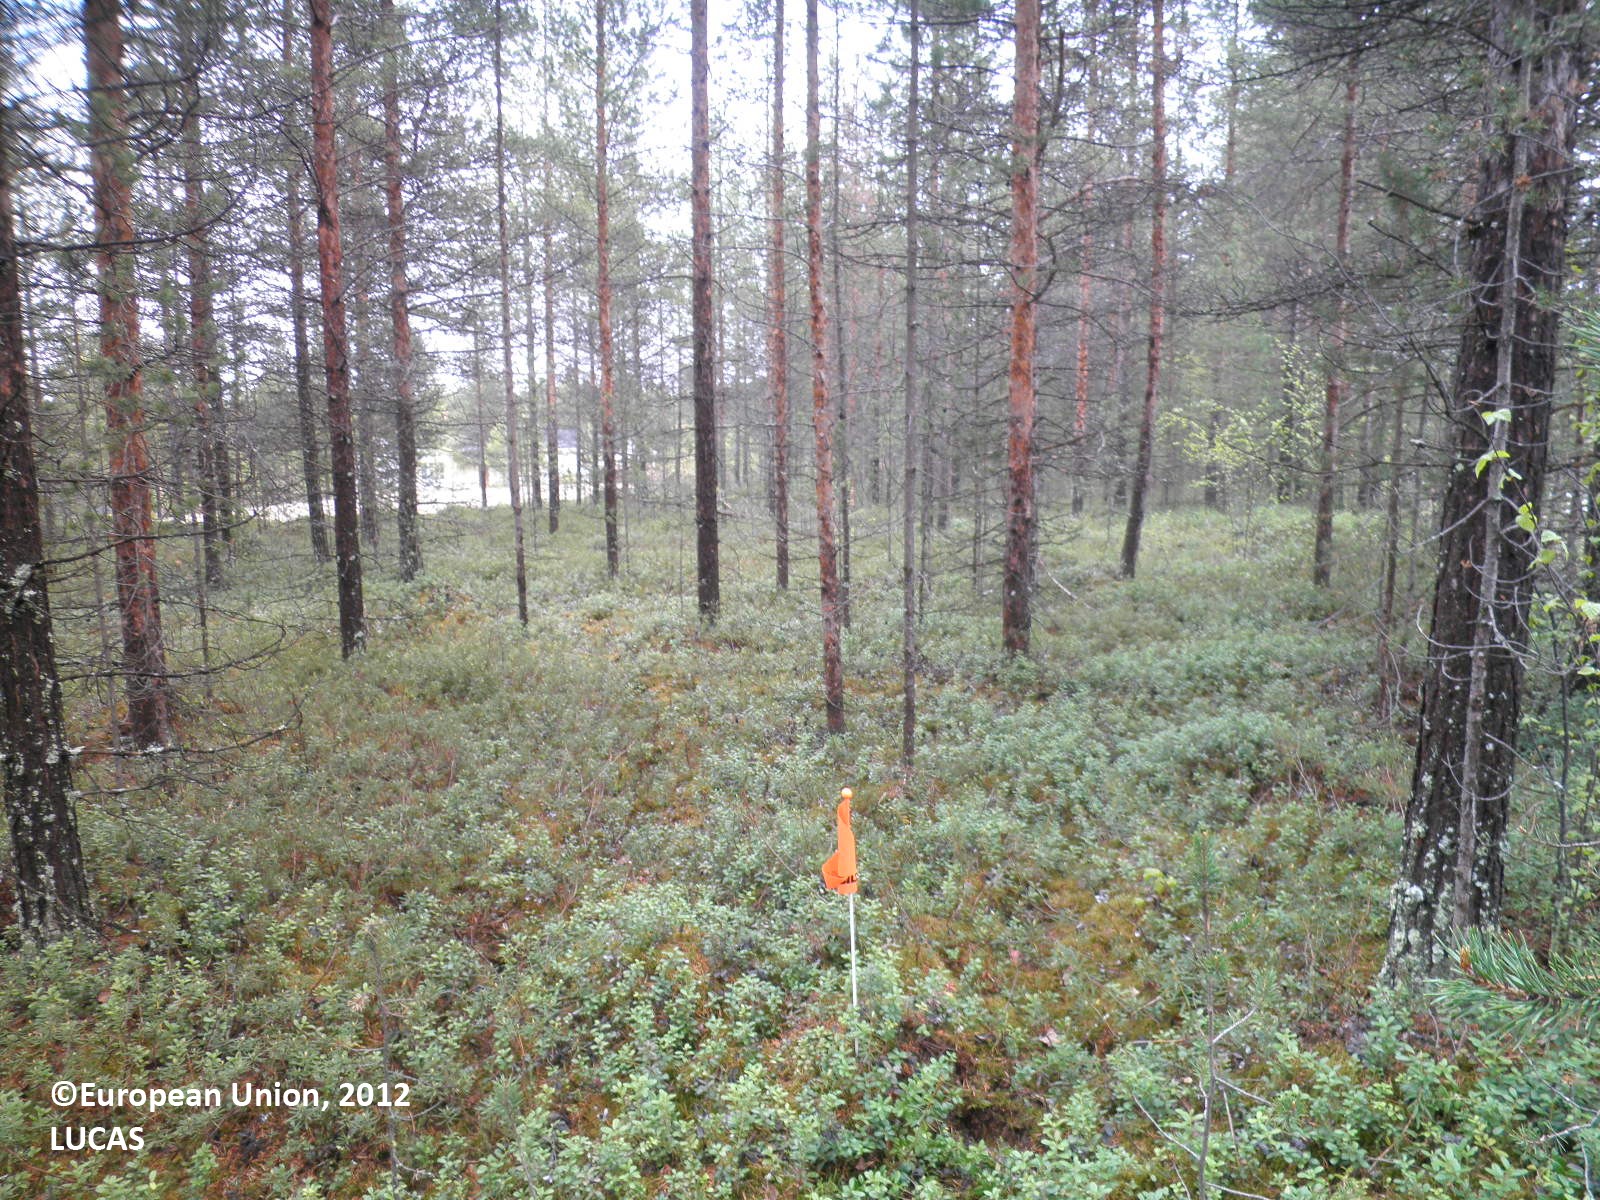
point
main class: Woodland
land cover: Pine dominated coniferous woodland
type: boreal forest
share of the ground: 25 - 50 %
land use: Forestry
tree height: > 5 m
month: June
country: FI
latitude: 68.7070
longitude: 27.7763
